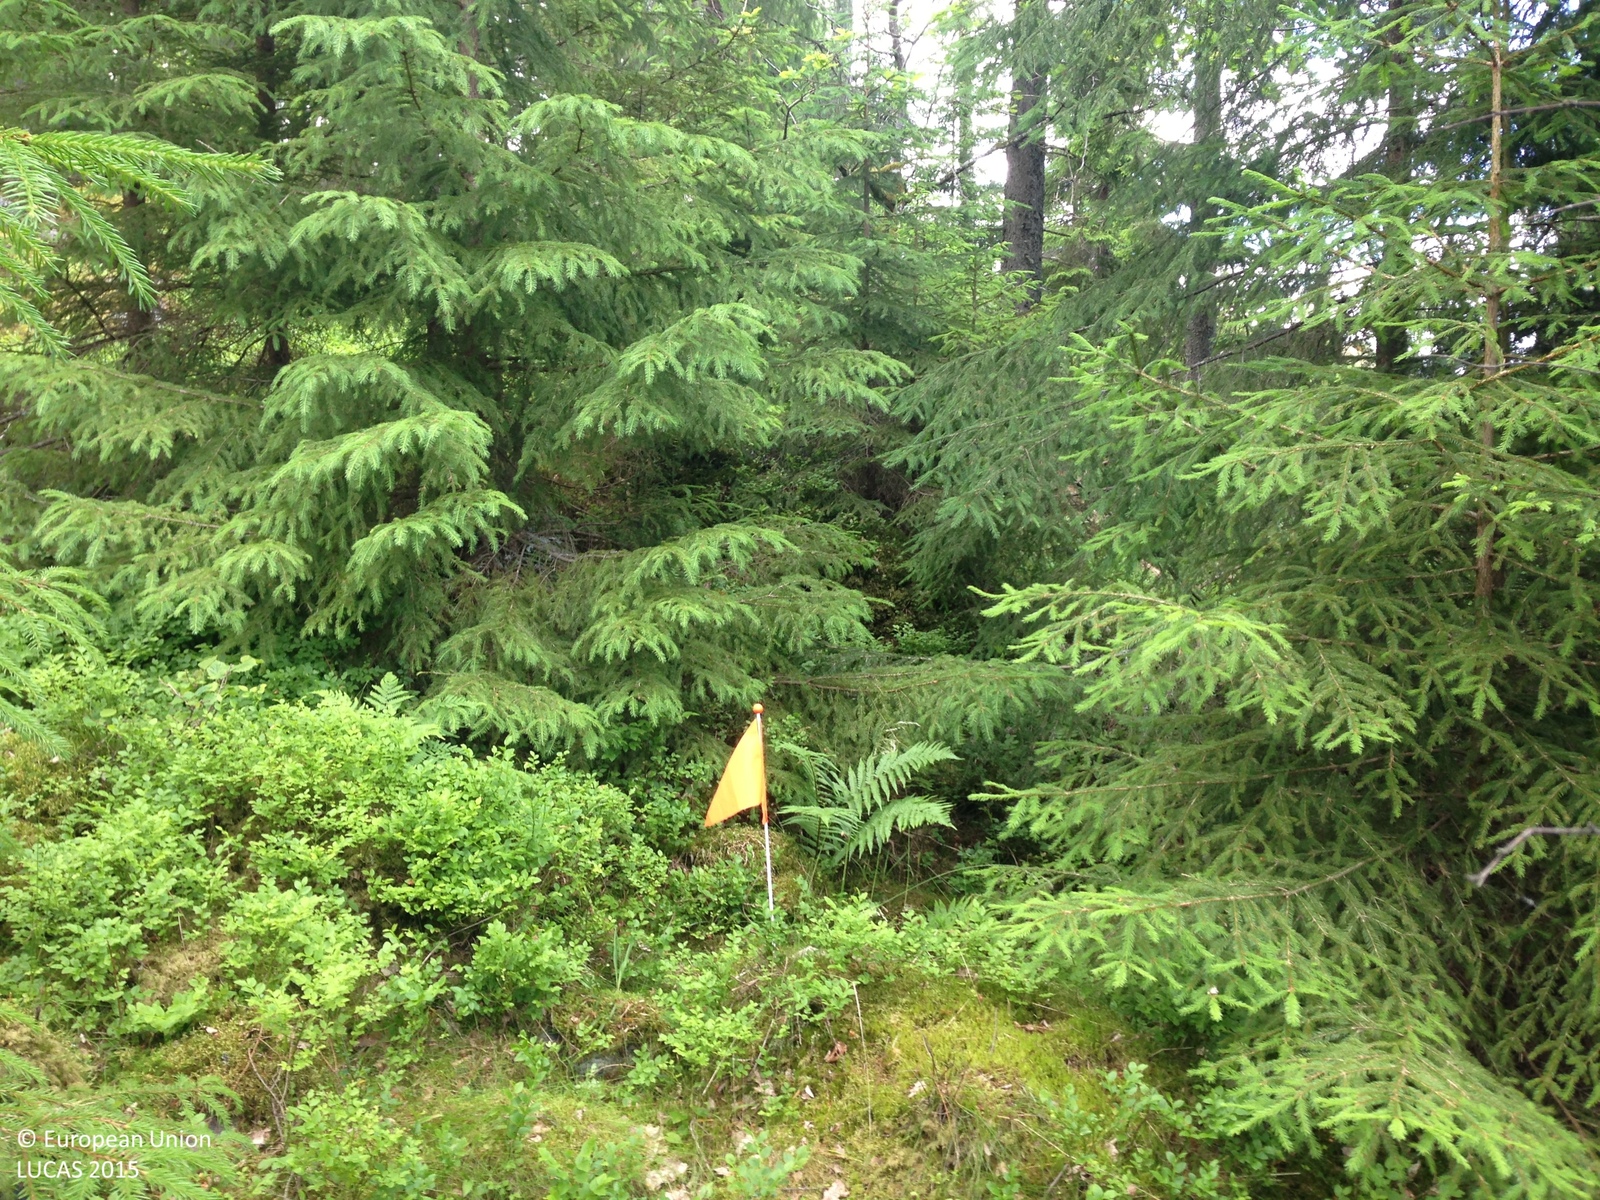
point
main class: Woodland
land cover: Spruce dominated coniferous woodland
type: boreal forest
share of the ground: 50 - 75 %
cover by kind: coniferous forest trees 60 %, shrubs 25 %, broadleaved forest trees 10 %, lichens and mosses 5 %
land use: Forestry
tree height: > 5 m
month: June
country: SE
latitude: 58.1246
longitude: 16.3298
